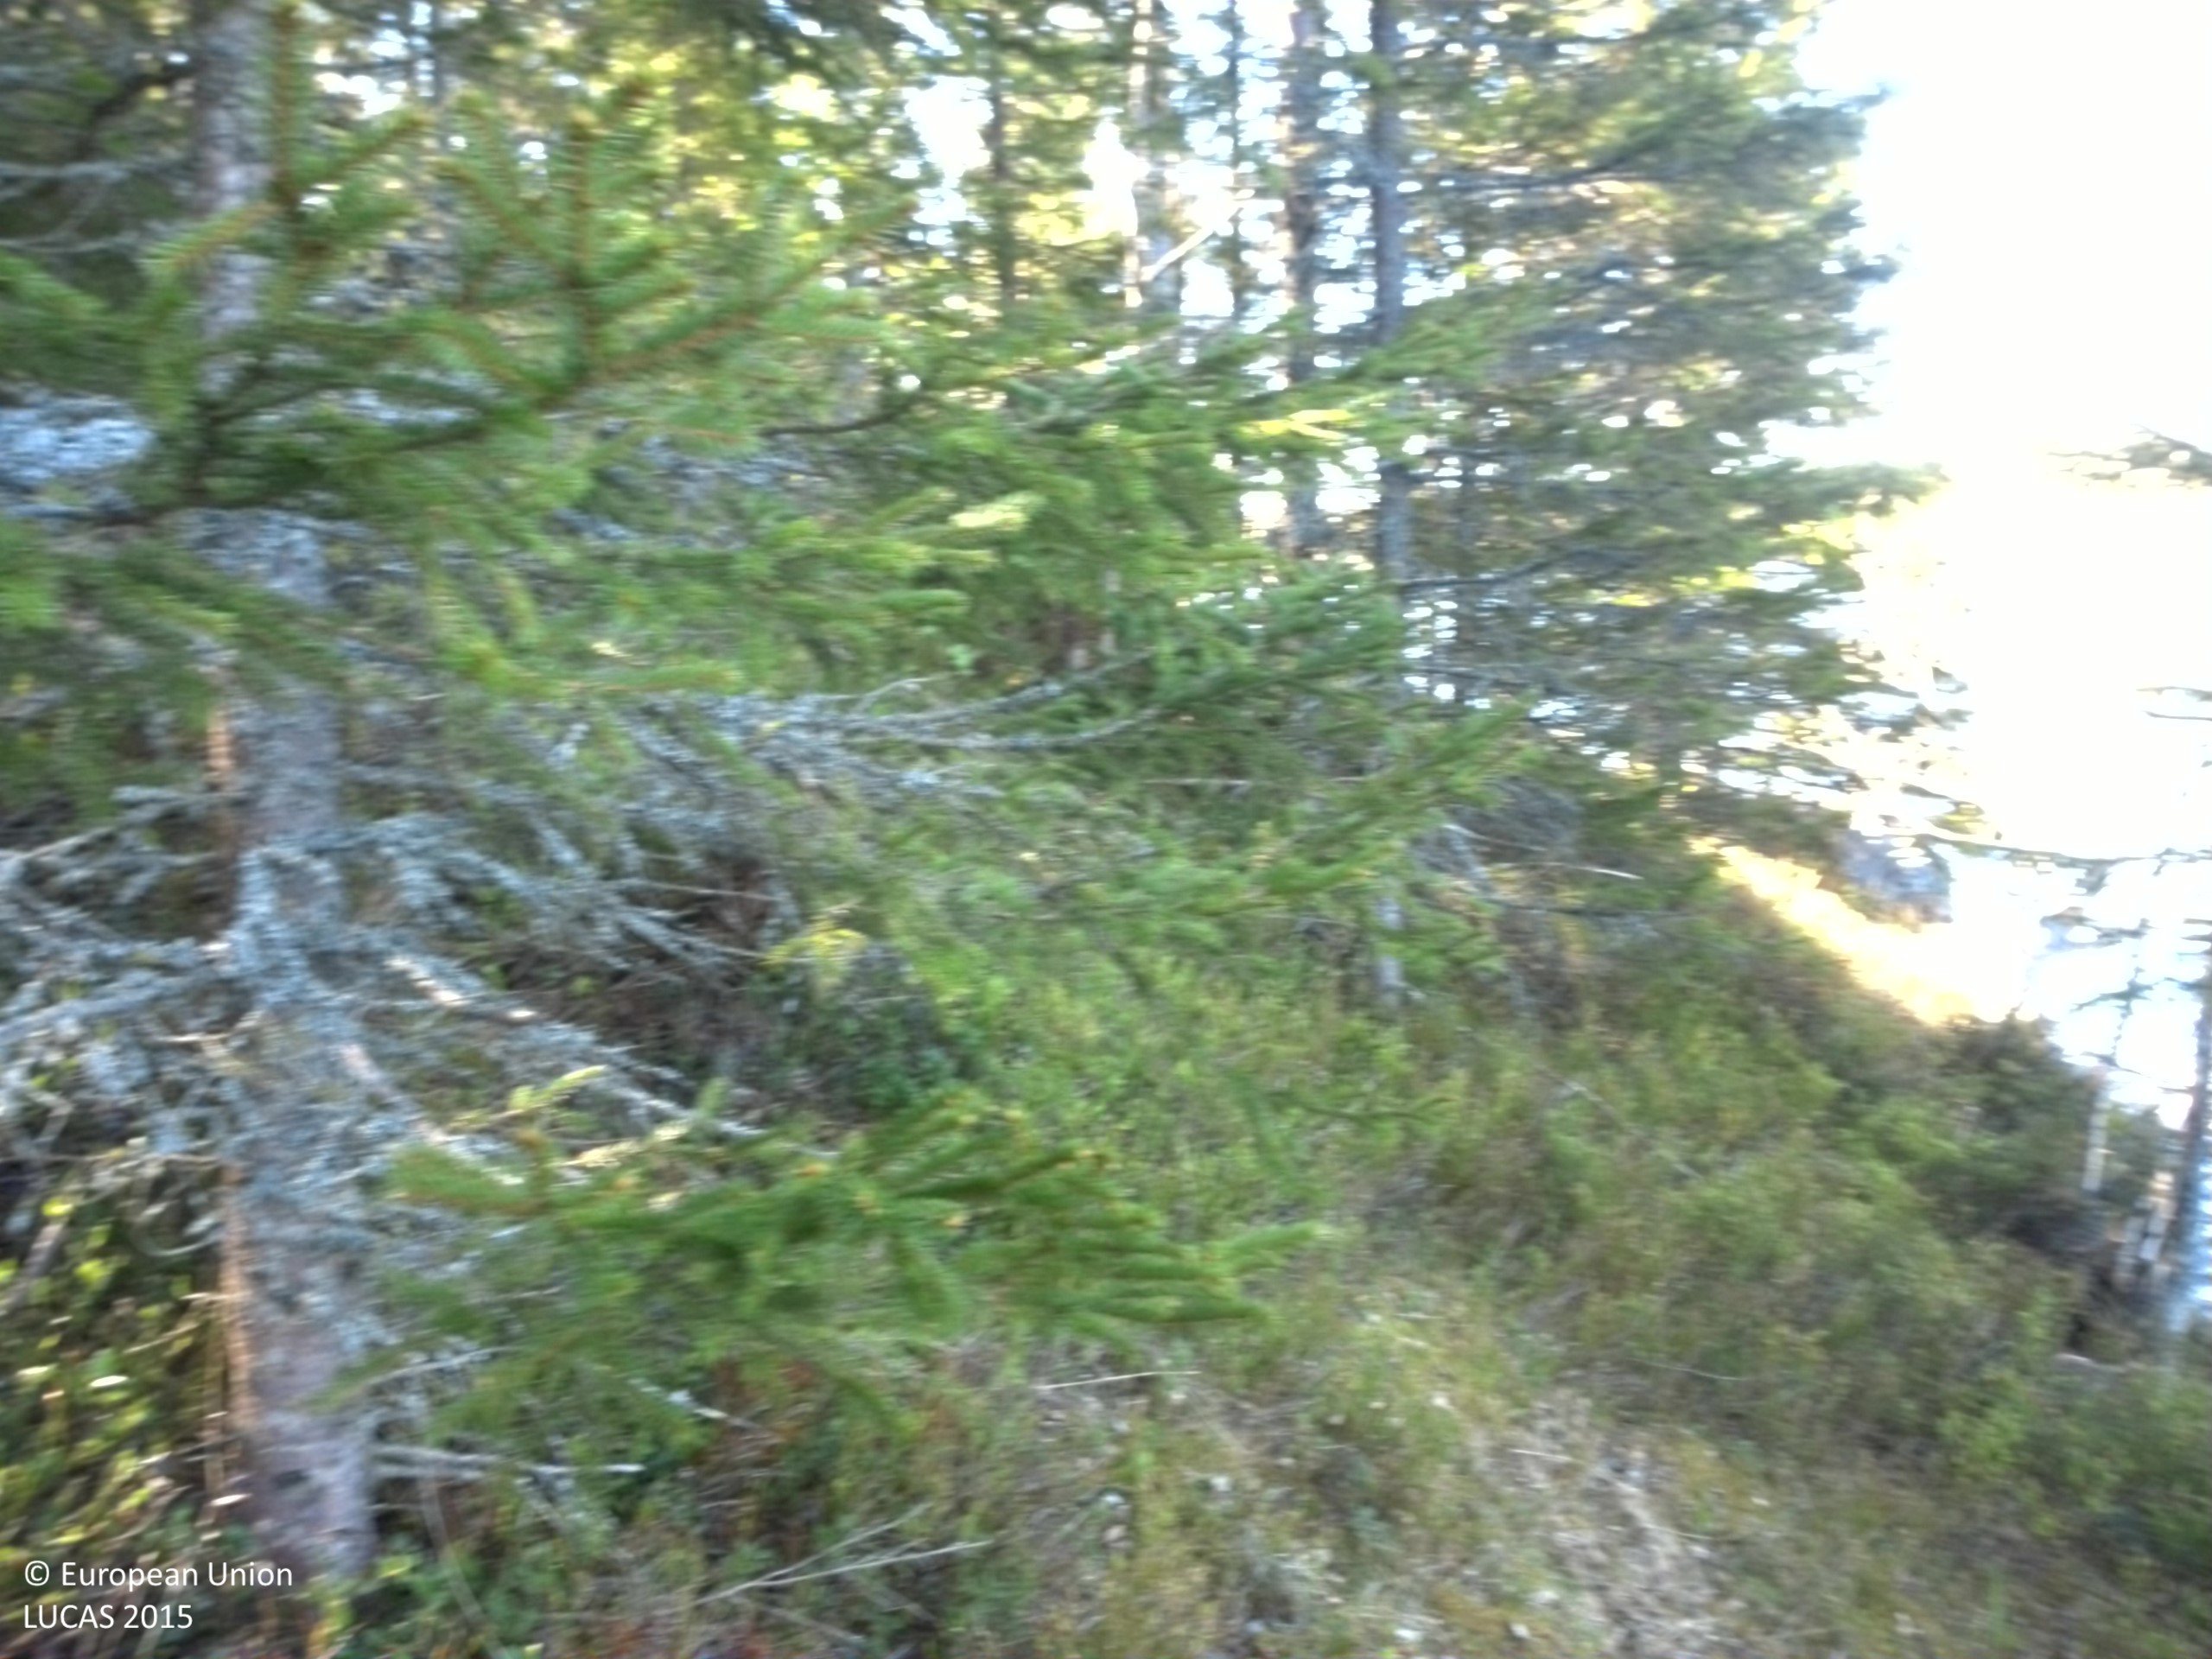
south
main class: Woodland
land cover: Pine dominated mixed woodland
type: boreal forest
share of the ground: > 75 %
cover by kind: coniferous forest trees 60 %, broadleaved forest trees 25 %, shrubs 15 %
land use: Residential
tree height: > 5 m
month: May
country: SE
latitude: 63.0352
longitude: 17.9837
